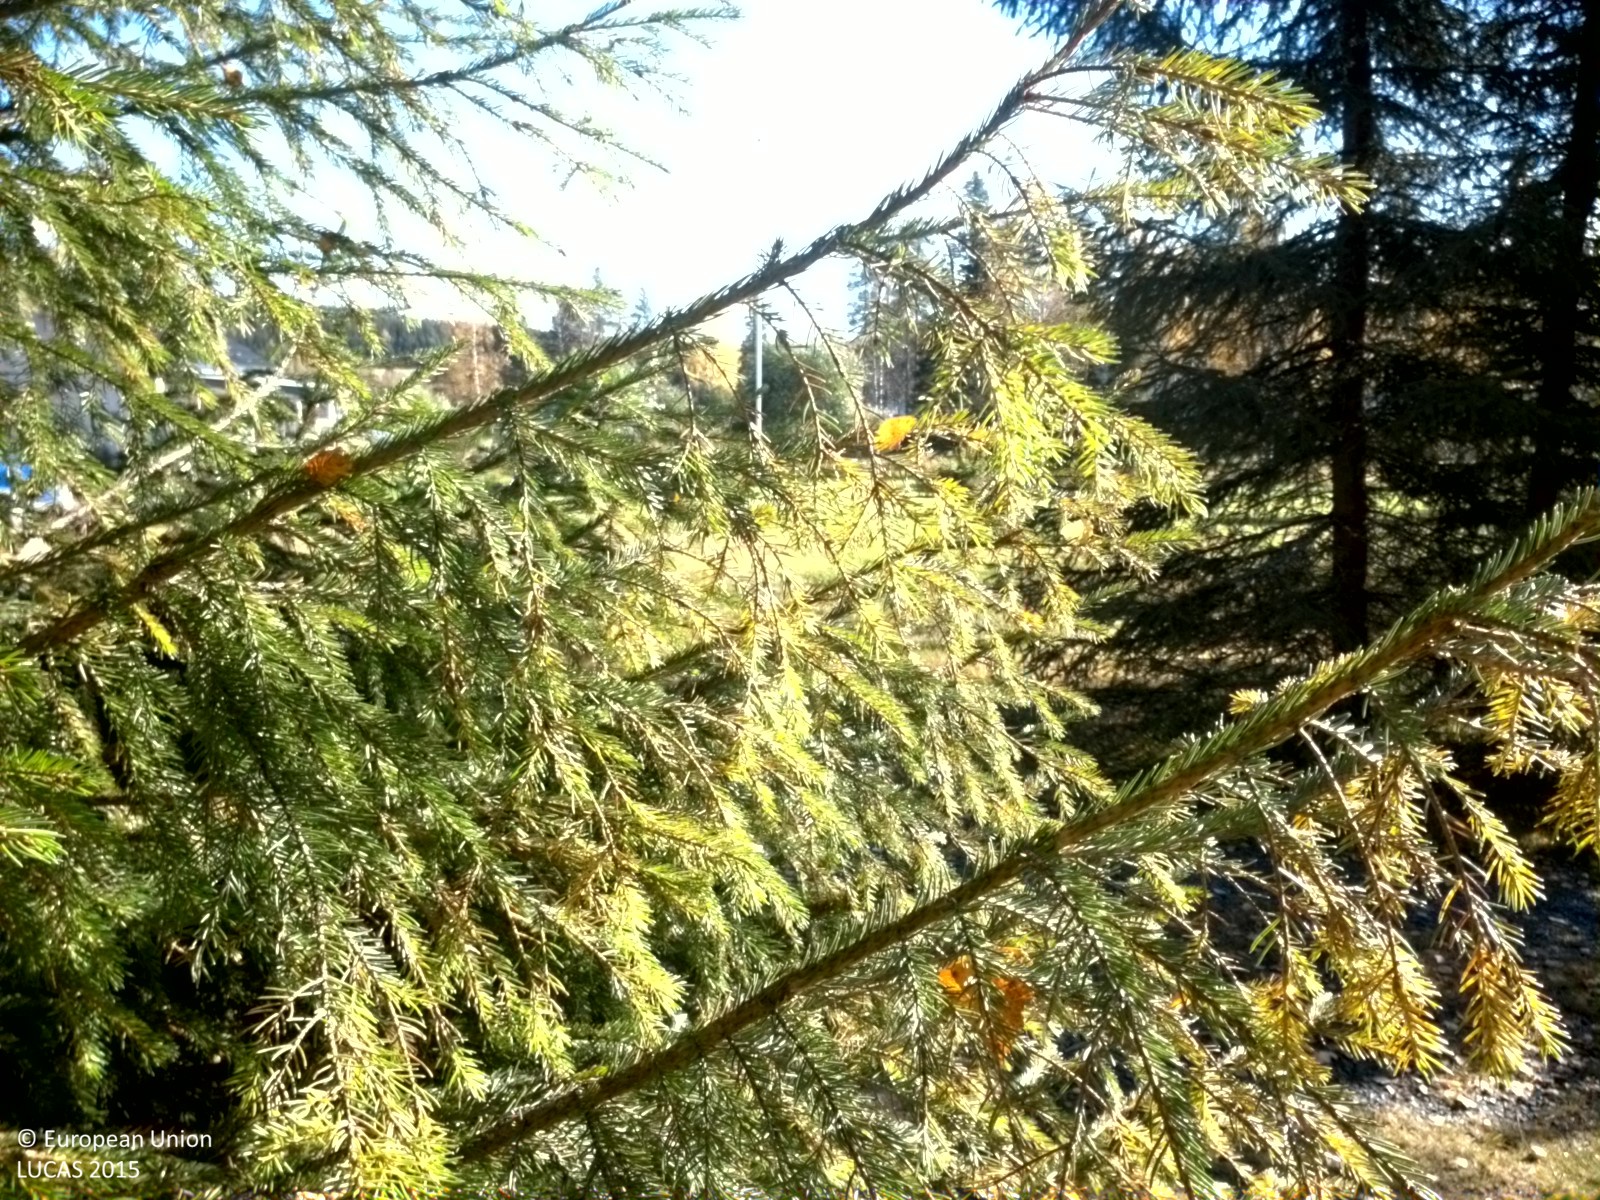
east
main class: Woodland
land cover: Spruce dominated mixed woodland
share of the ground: 50 - 75 %
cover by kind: coniferous forest trees 40 %, shrubs 30 %, broadleaved forest trees 20 %, herbaceous plants 10 %
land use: Residential
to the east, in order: Spruce dominated mixed woodland; Artificial constructions in urban areas; Shruby margins; Ditches and canals; Grassland without tree/shrub cover; Pine dominated coniferous woodland; Shrubland with sparse tree cover; Rocks and stones; Inland fresh water bodies
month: October
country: SE
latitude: 65.7620
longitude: 21.3876
